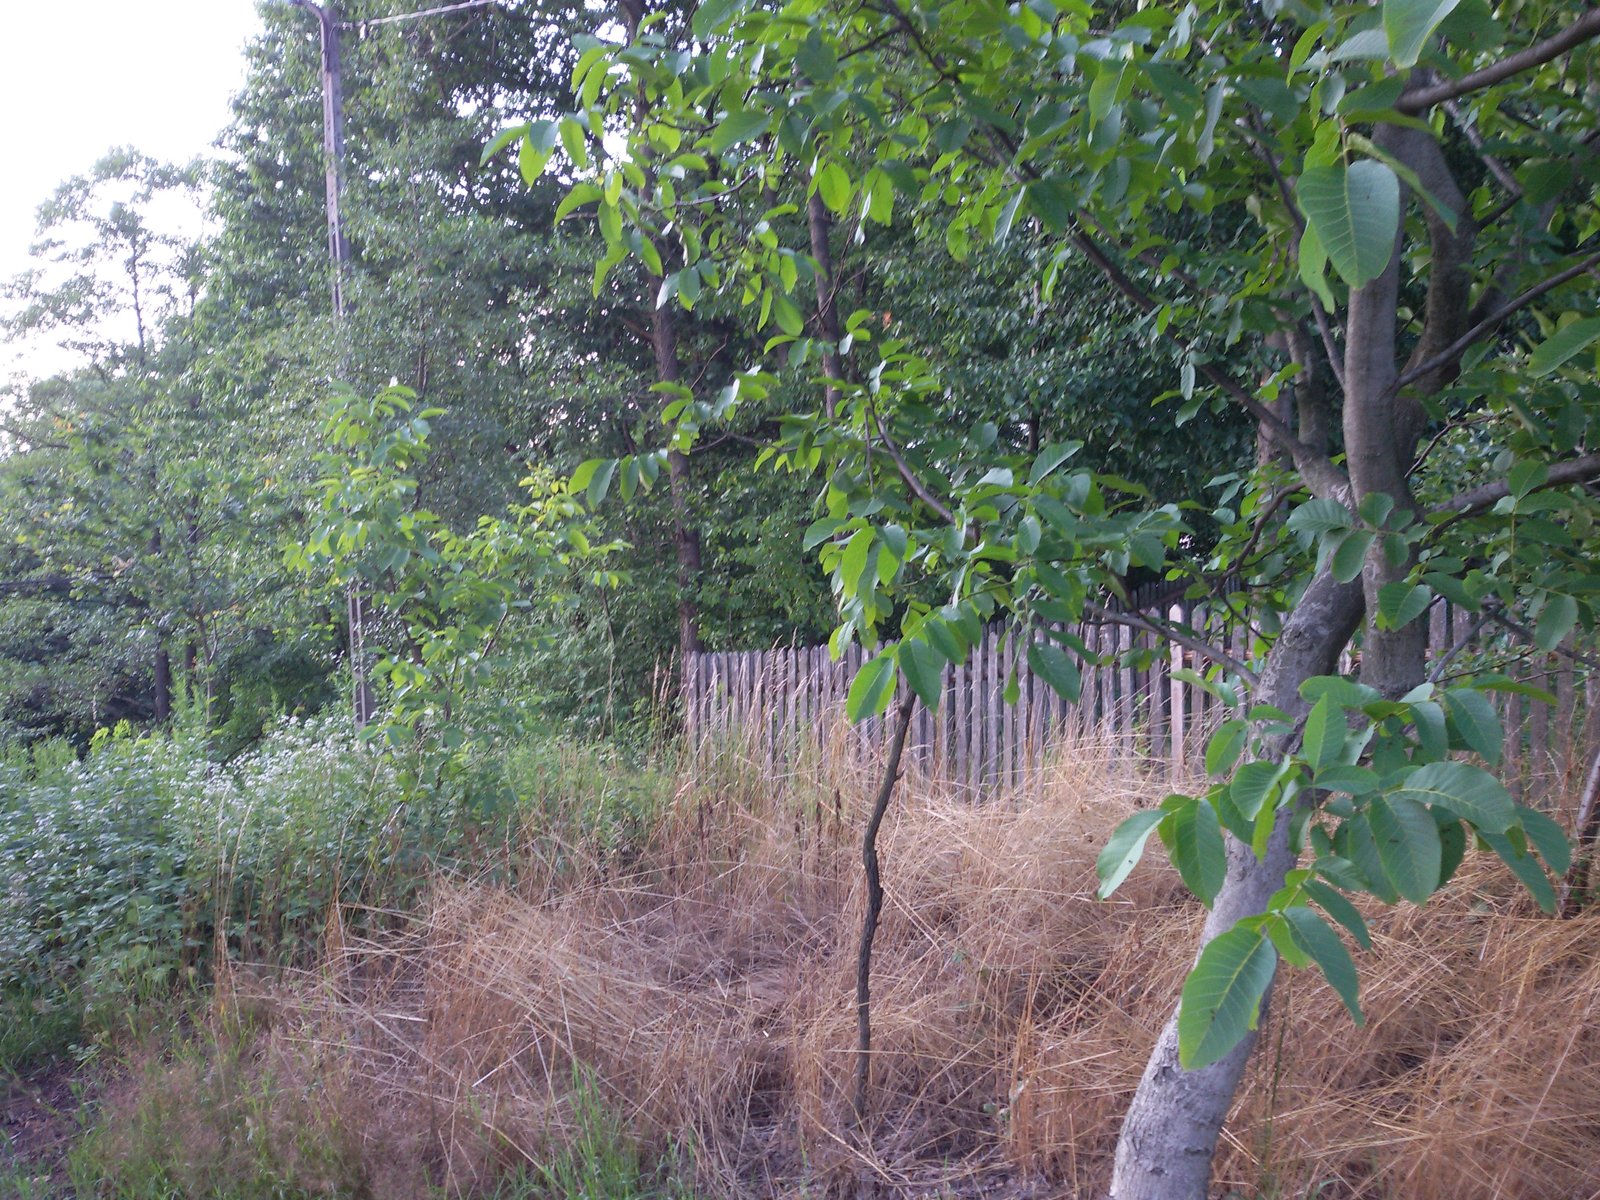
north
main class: Grassland
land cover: Grassland with sparse tree/shrub cover
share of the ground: 50 - 75 %
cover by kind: herbaceous plants 95 %, coniferous forest trees 5 %
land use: Residential
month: July
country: PL
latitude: 50.2158
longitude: 22.3820
